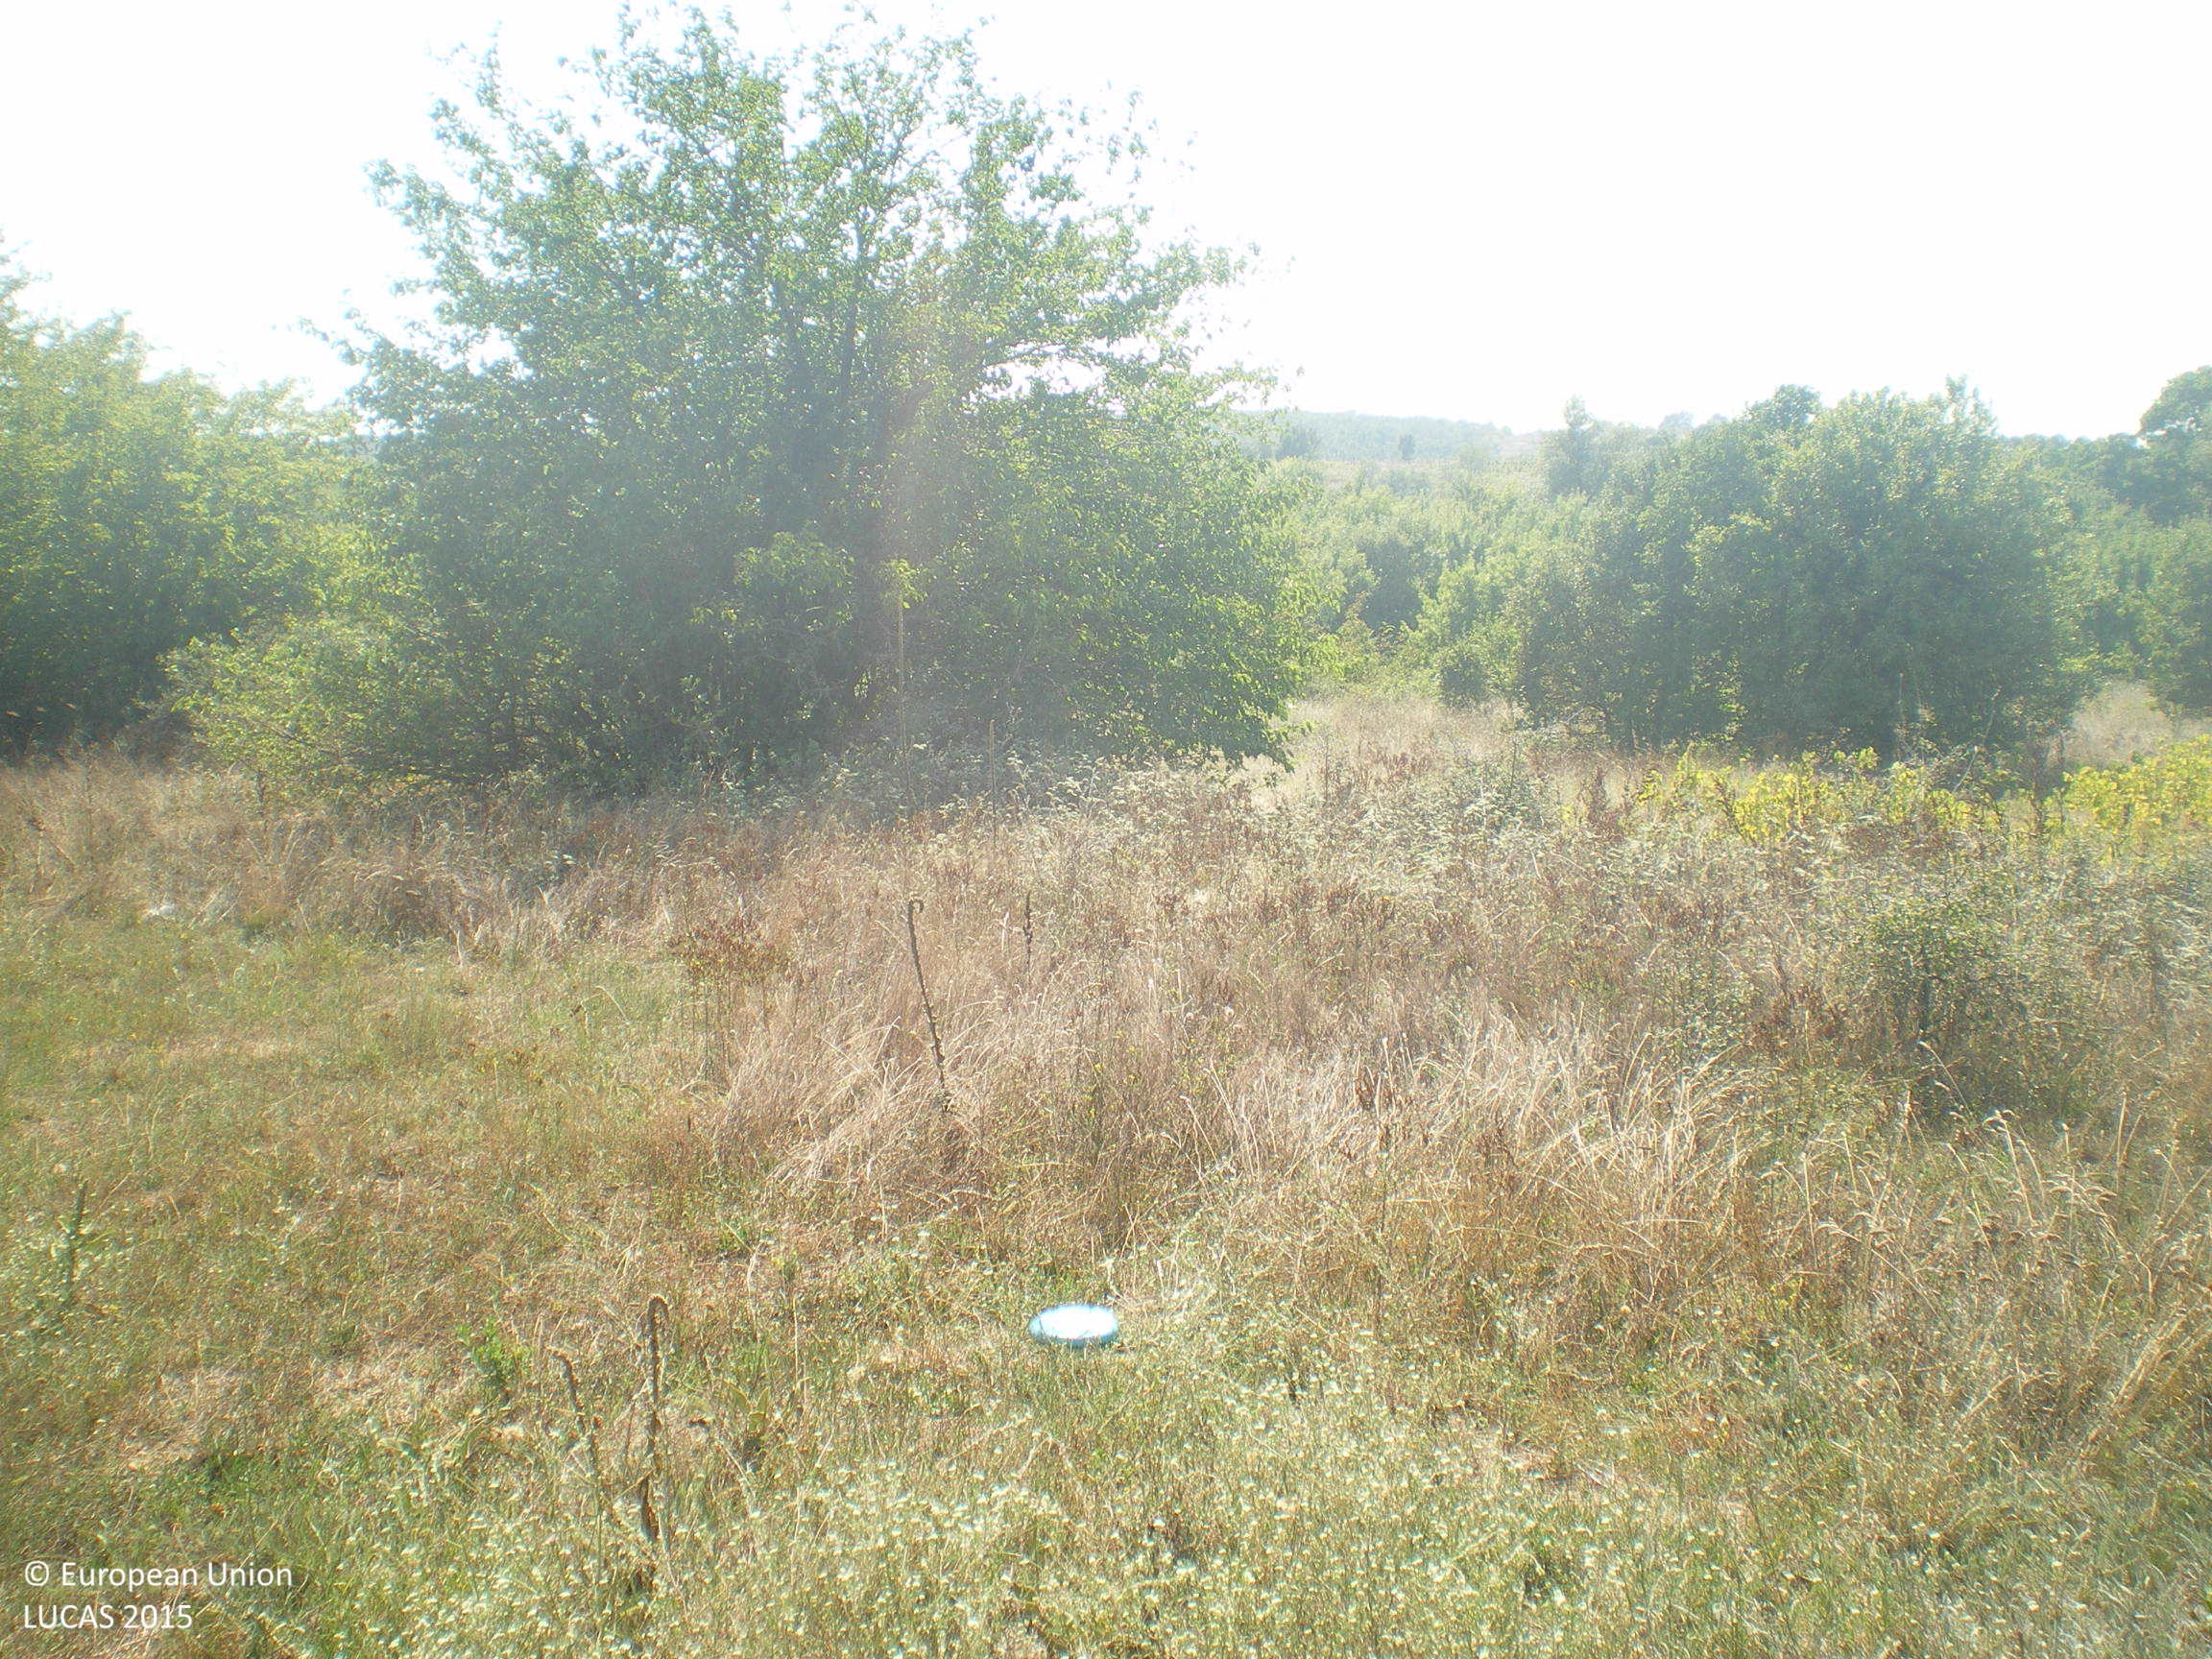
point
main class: Grassland
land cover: Grassland with sparse tree/shrub cover
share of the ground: > 75 %
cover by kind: herbaceous plants 90 %, broadleaved forest trees 5 %, shrubs 5 %
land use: Agriculture (excluding fallow land and kitchen gardens)
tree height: > 5 m
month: August
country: BG
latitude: 42.0428
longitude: 26.0593
